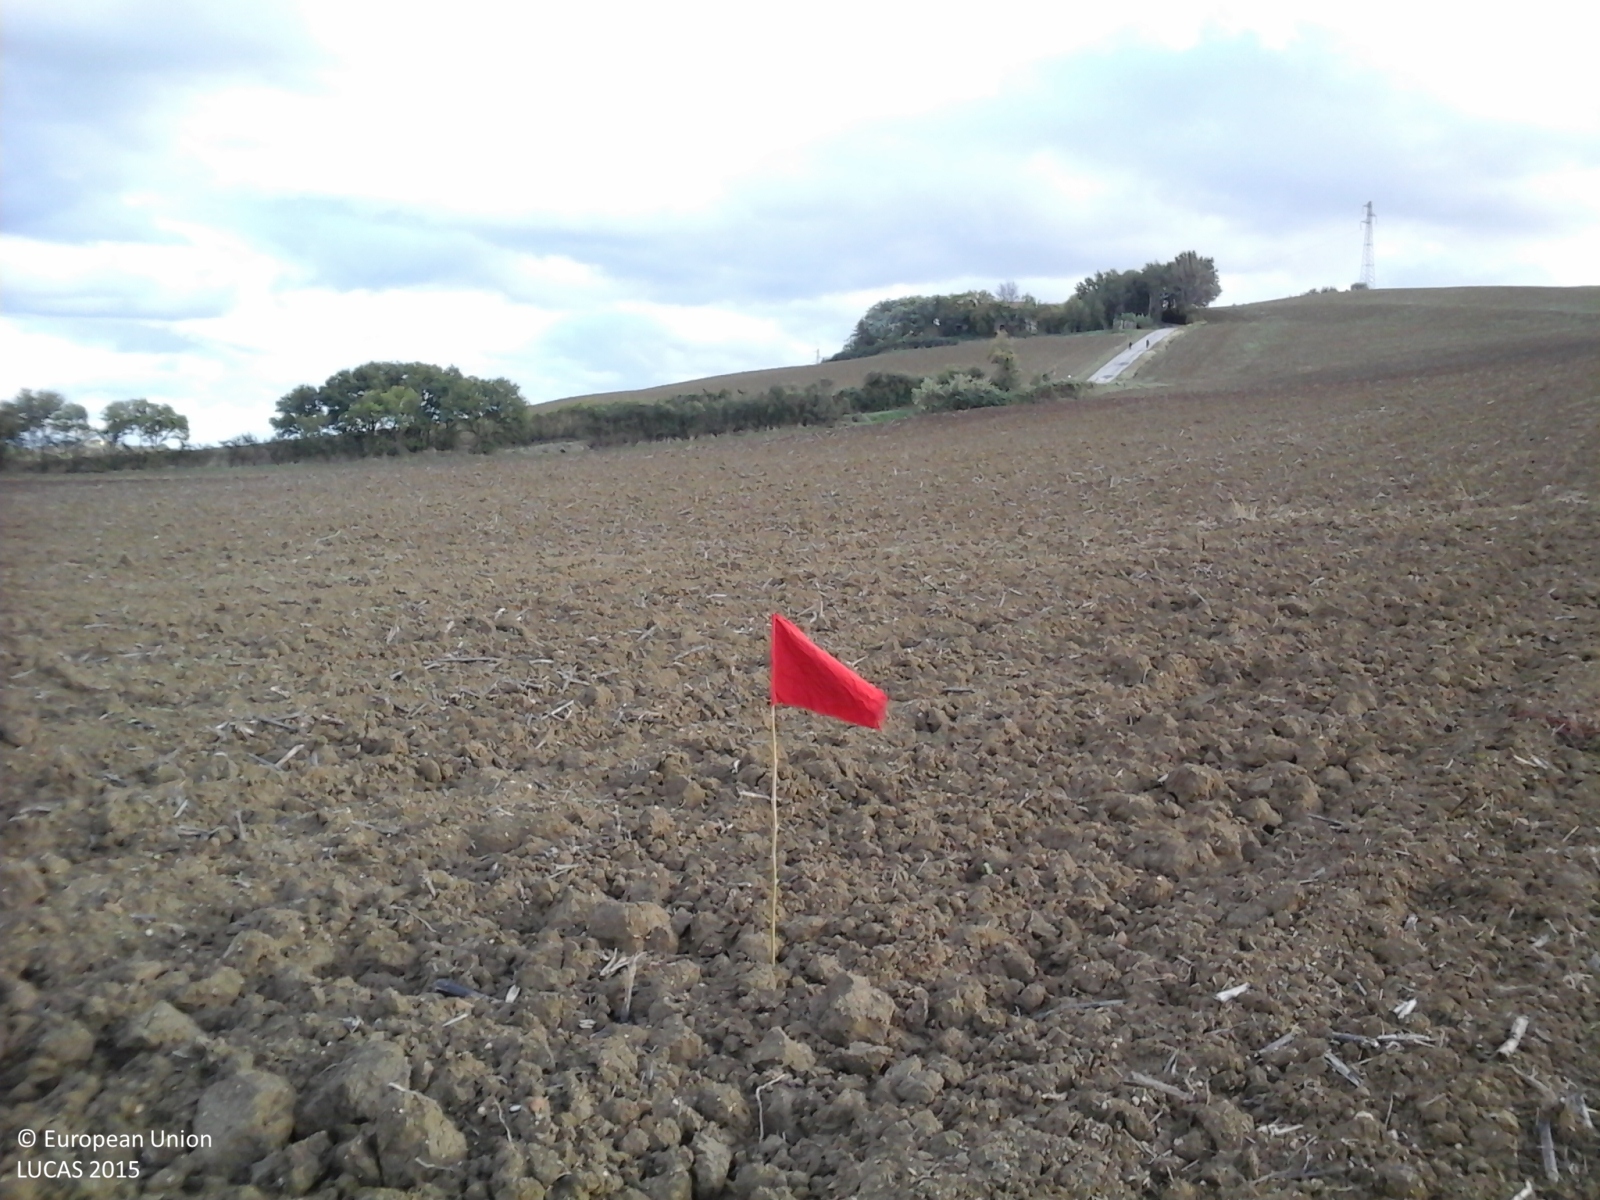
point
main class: Cropland
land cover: Sunflower
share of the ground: < 10 %
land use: Agriculture (excluding fallow land and kitchen gardens)
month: October
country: IT
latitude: 43.6677
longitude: 13.2540
